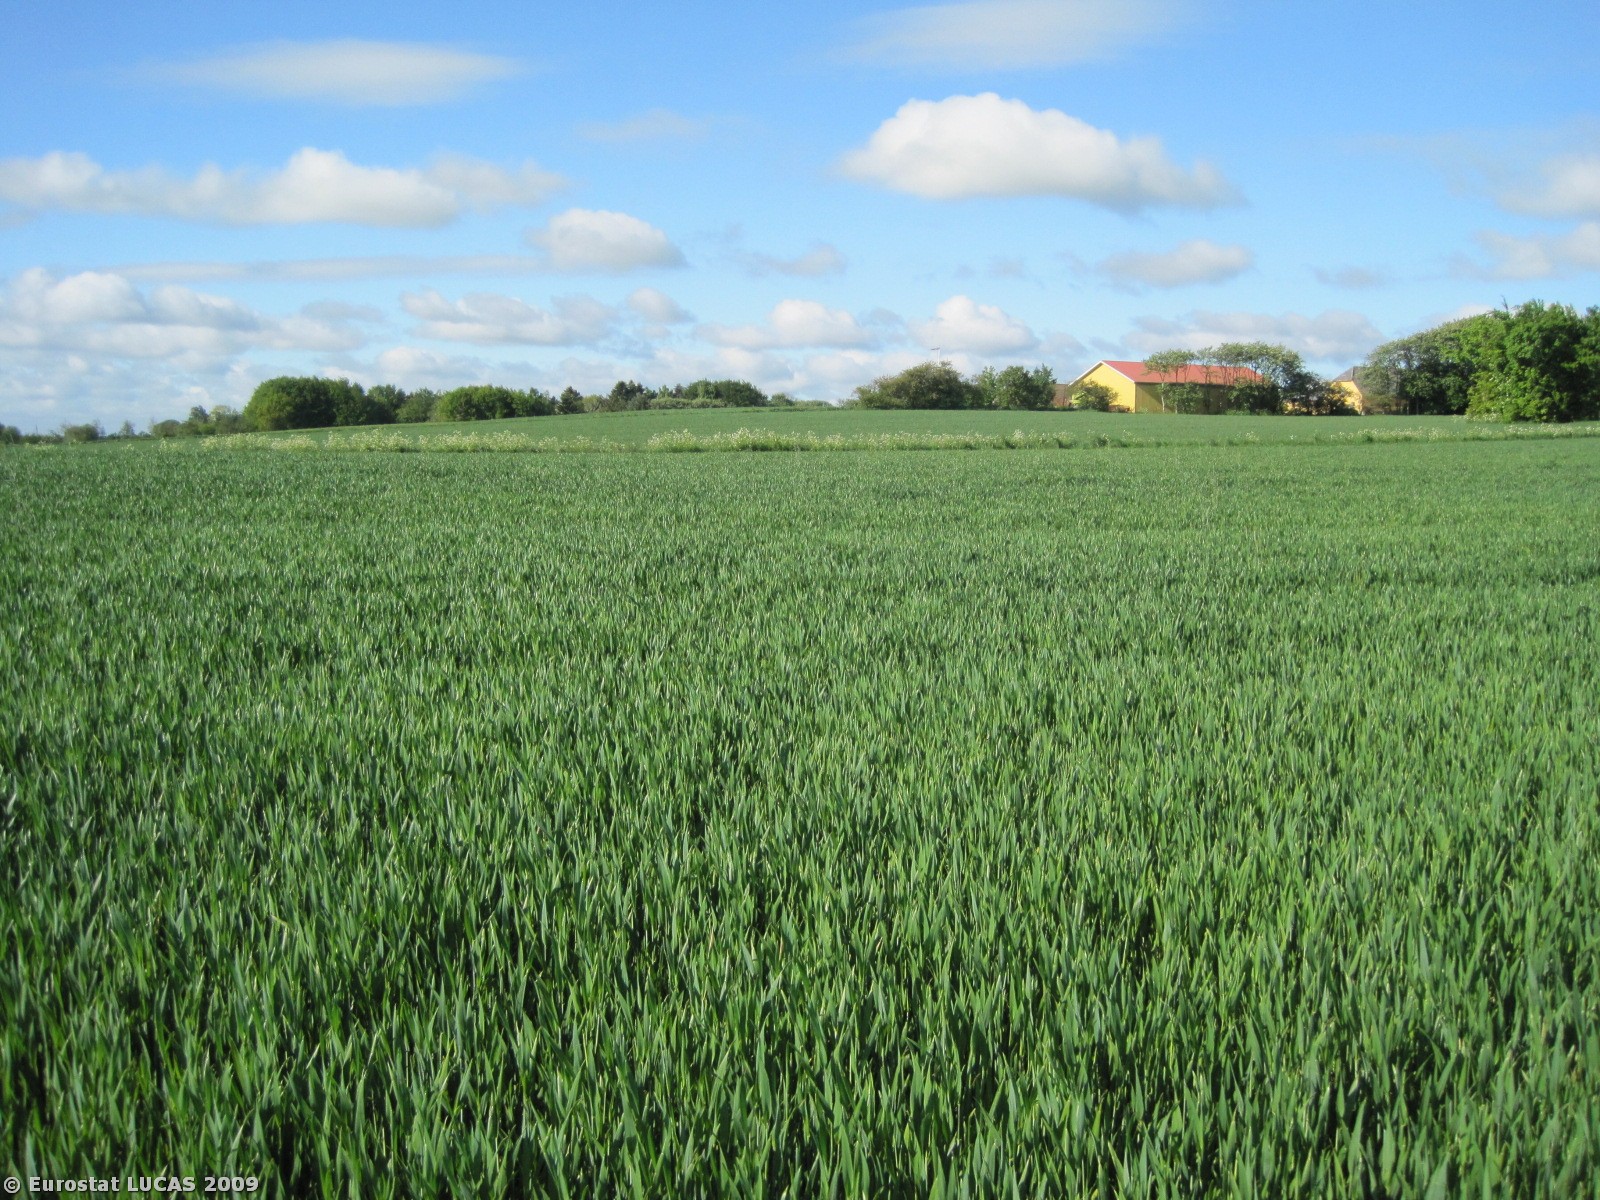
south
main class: Cropland
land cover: Common wheat
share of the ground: > 75 %
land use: Agriculture (excluding fallow land and kitchen gardens)
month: May
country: DK
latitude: 56.8708
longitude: 10.0164
